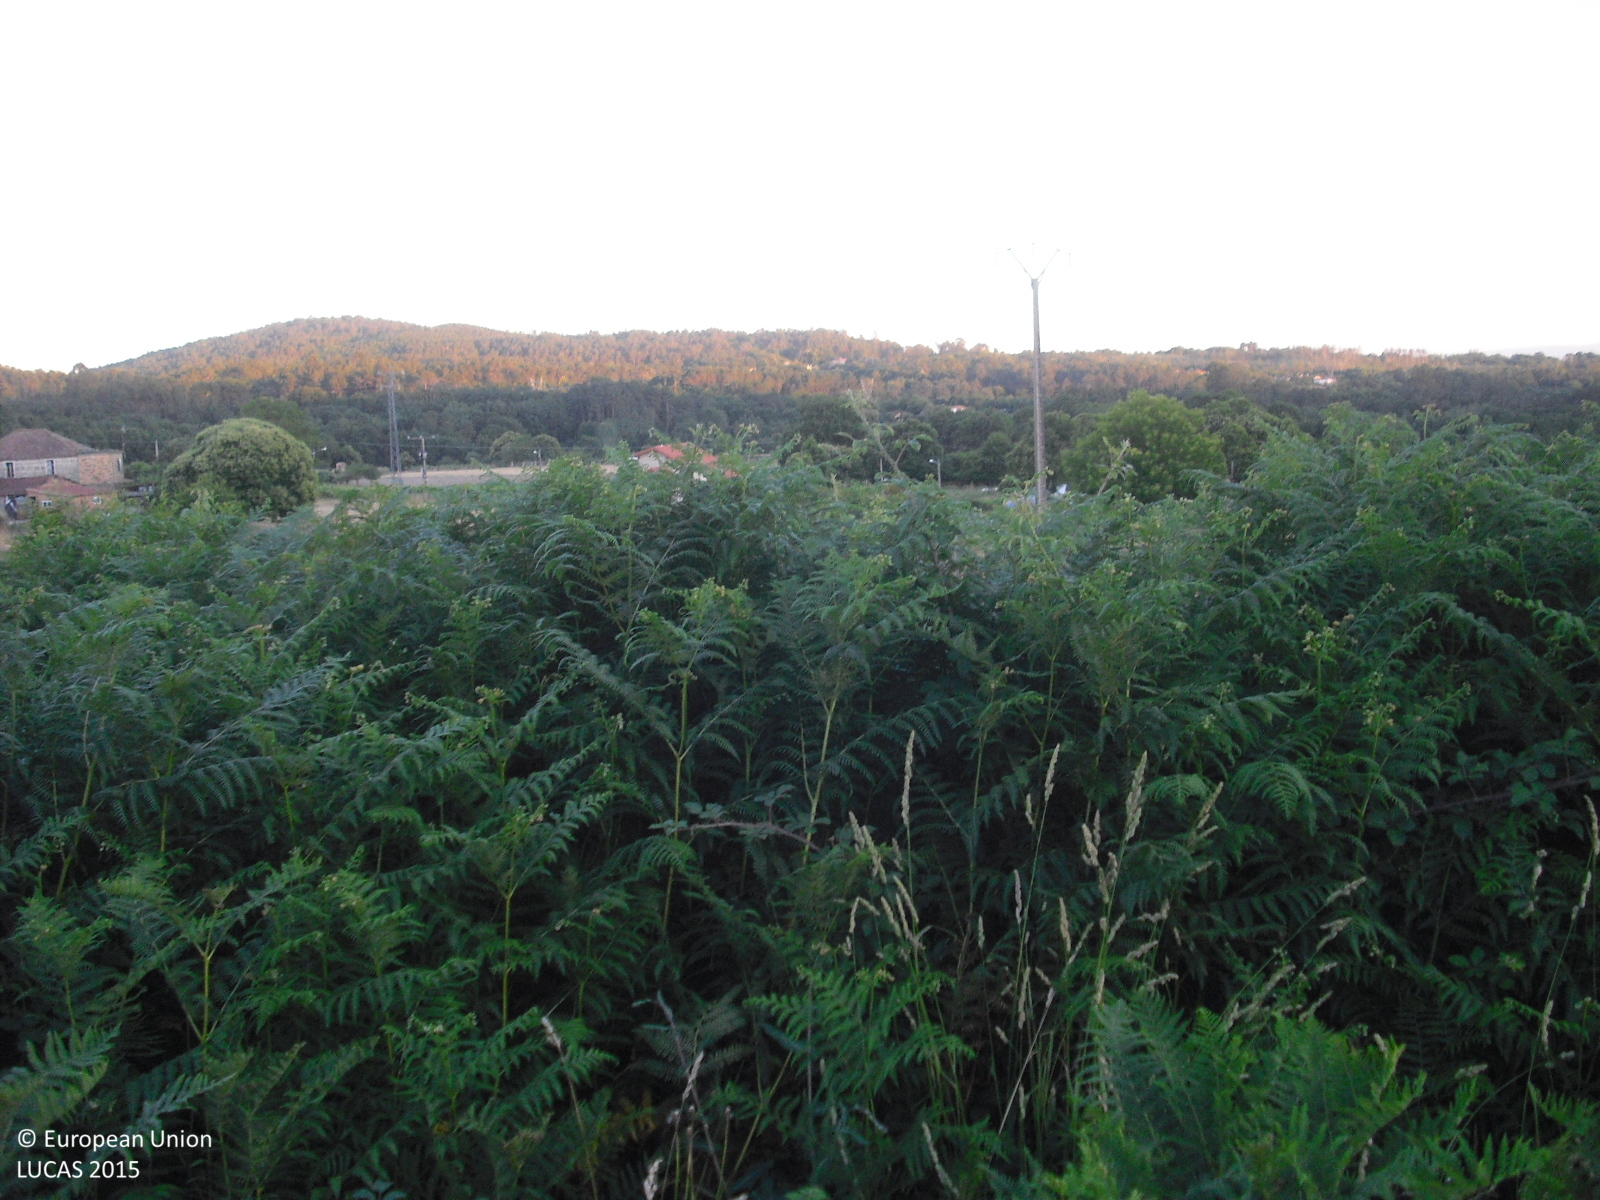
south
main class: Shrubland
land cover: Shrubland without tree cover
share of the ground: 50 - 75 %
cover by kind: shrubs 70 %, herbaceous plants 30 %
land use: Abandoned areas
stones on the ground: 25 - 50 %
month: June
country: ES
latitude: 42.4697
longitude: -7.8731
